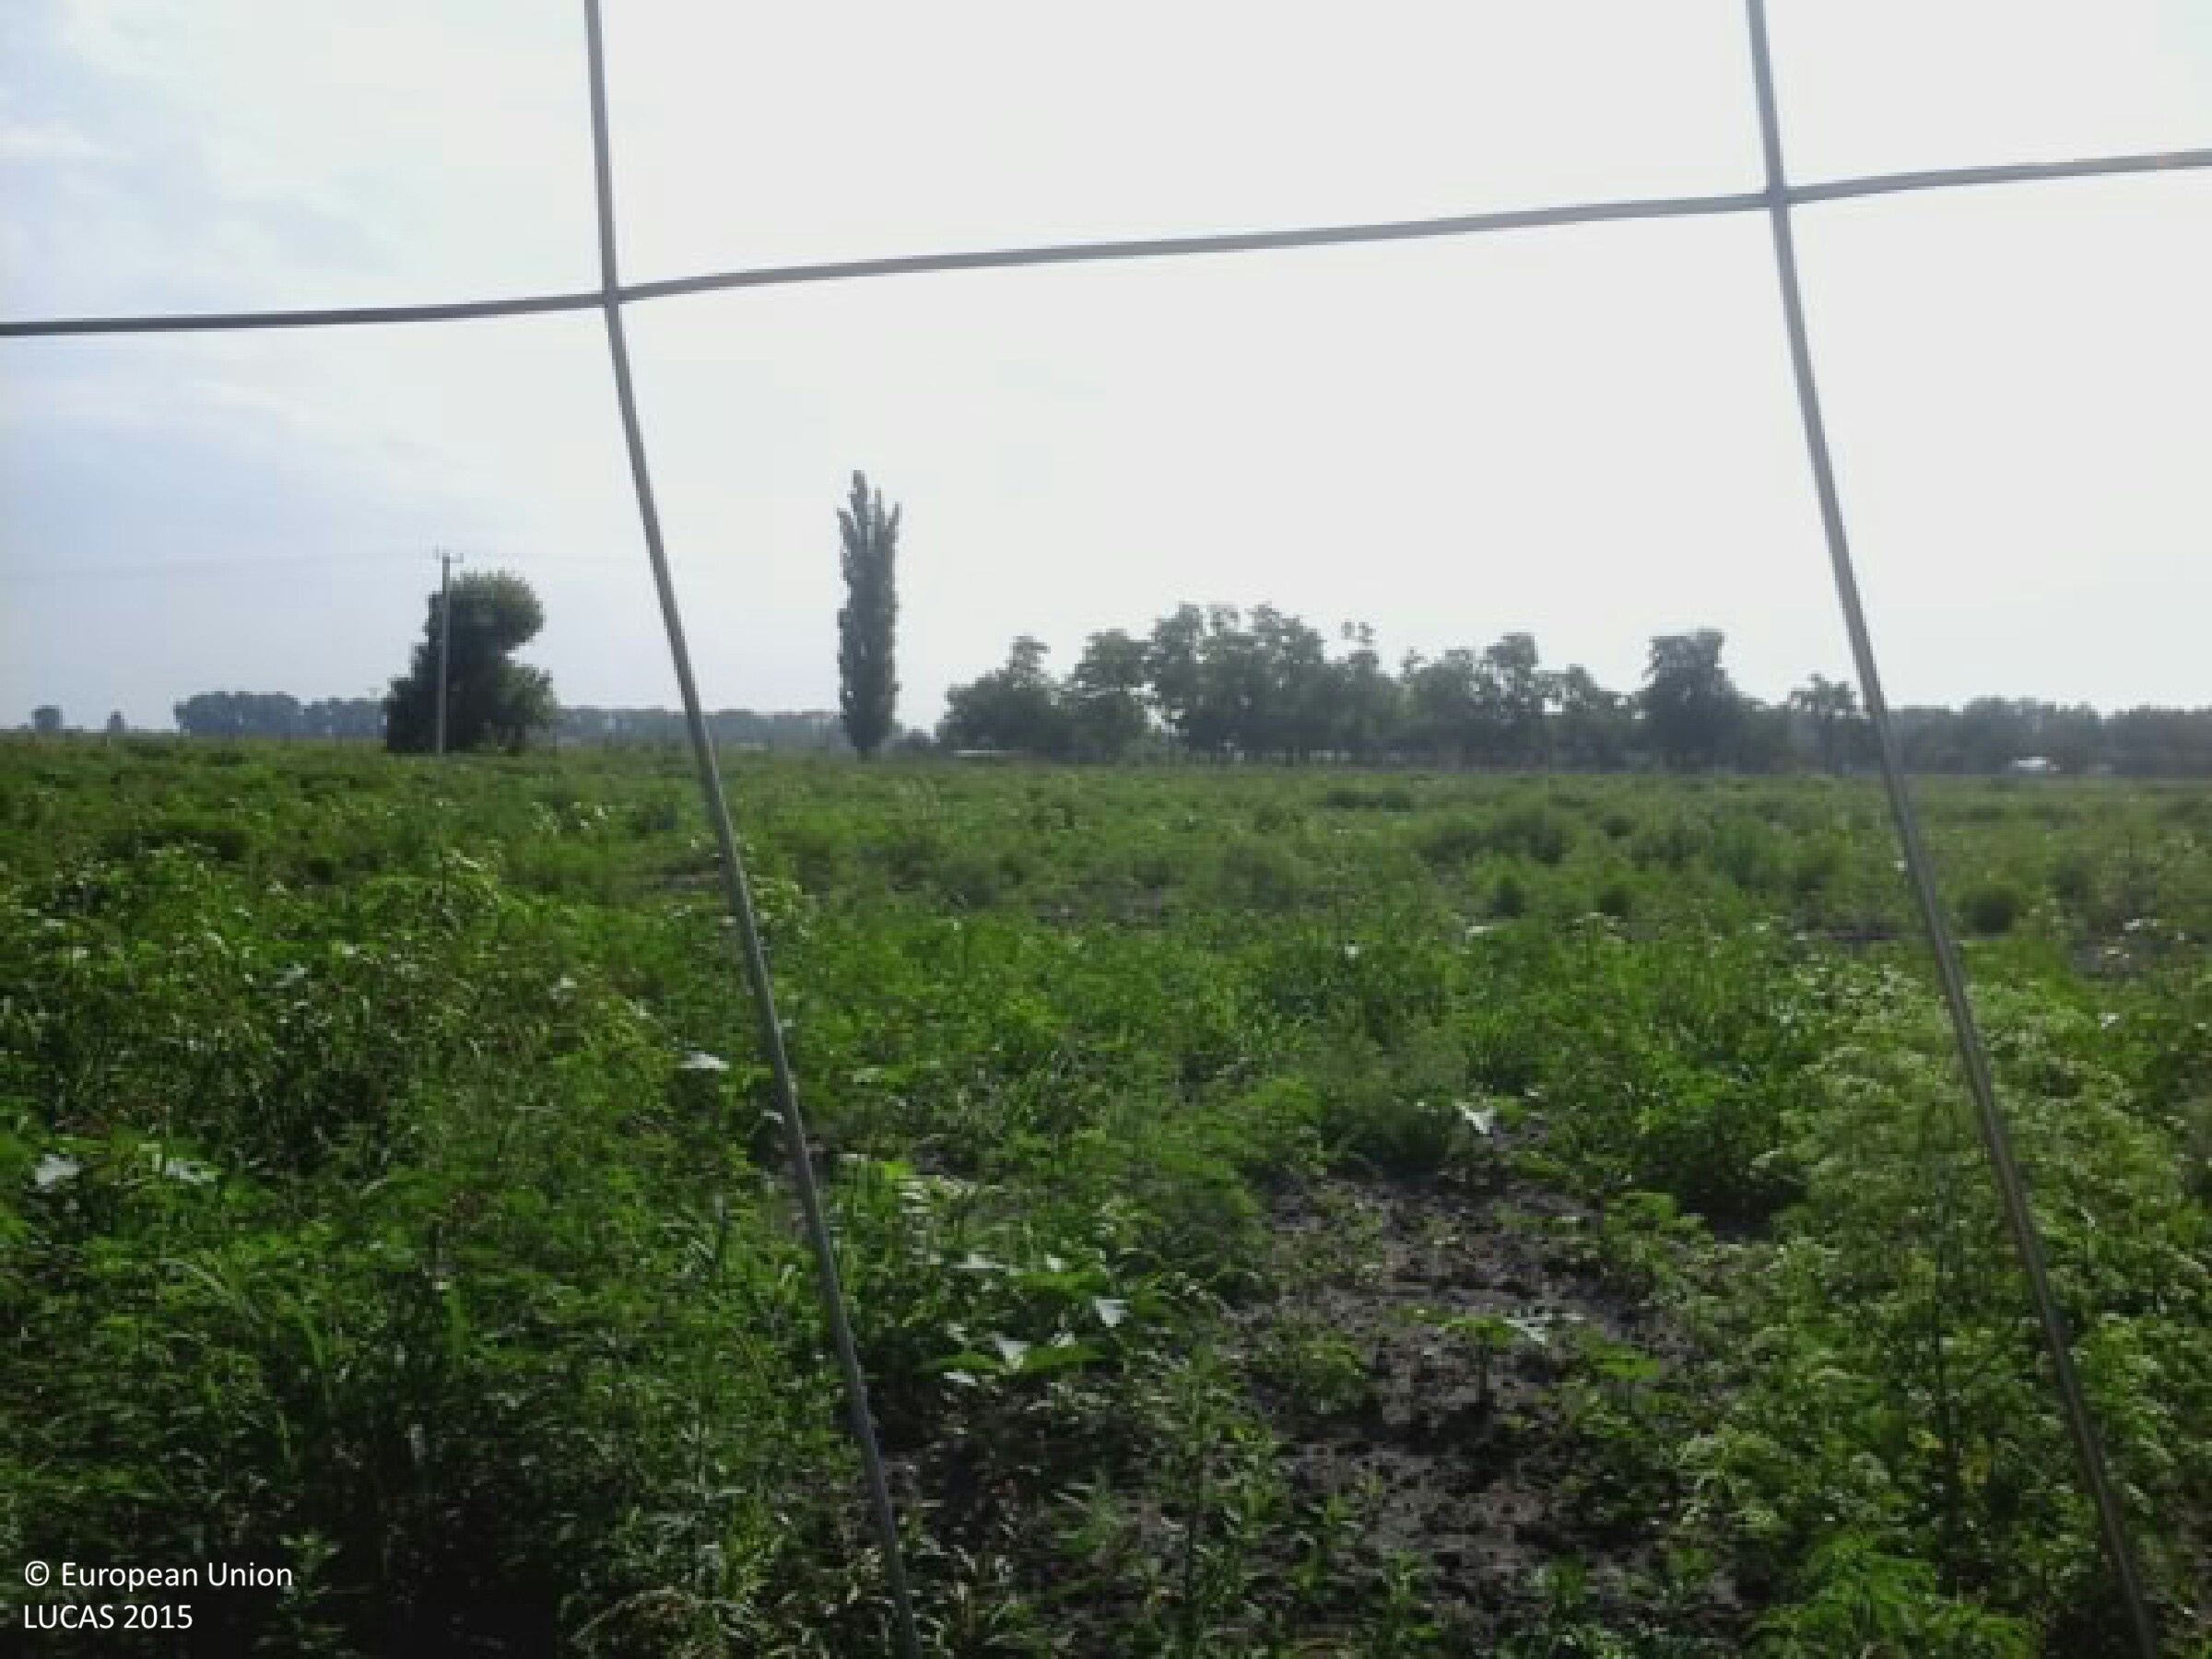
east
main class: Grassland
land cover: Spontaneously vegetated surfaces
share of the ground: > 75 %
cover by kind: herbaceous plants 100 %
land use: Fallow land
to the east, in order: Spontaneously vegetated surfaces; Electric lines; Other bare soil; Fences; Other bare soil; Artificial constructions in urban areas; Other bare soil; Grass margins; Fences; Grass margins; Other fruit trees and berries
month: August
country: HU
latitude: 47.1744
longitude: 19.7463
